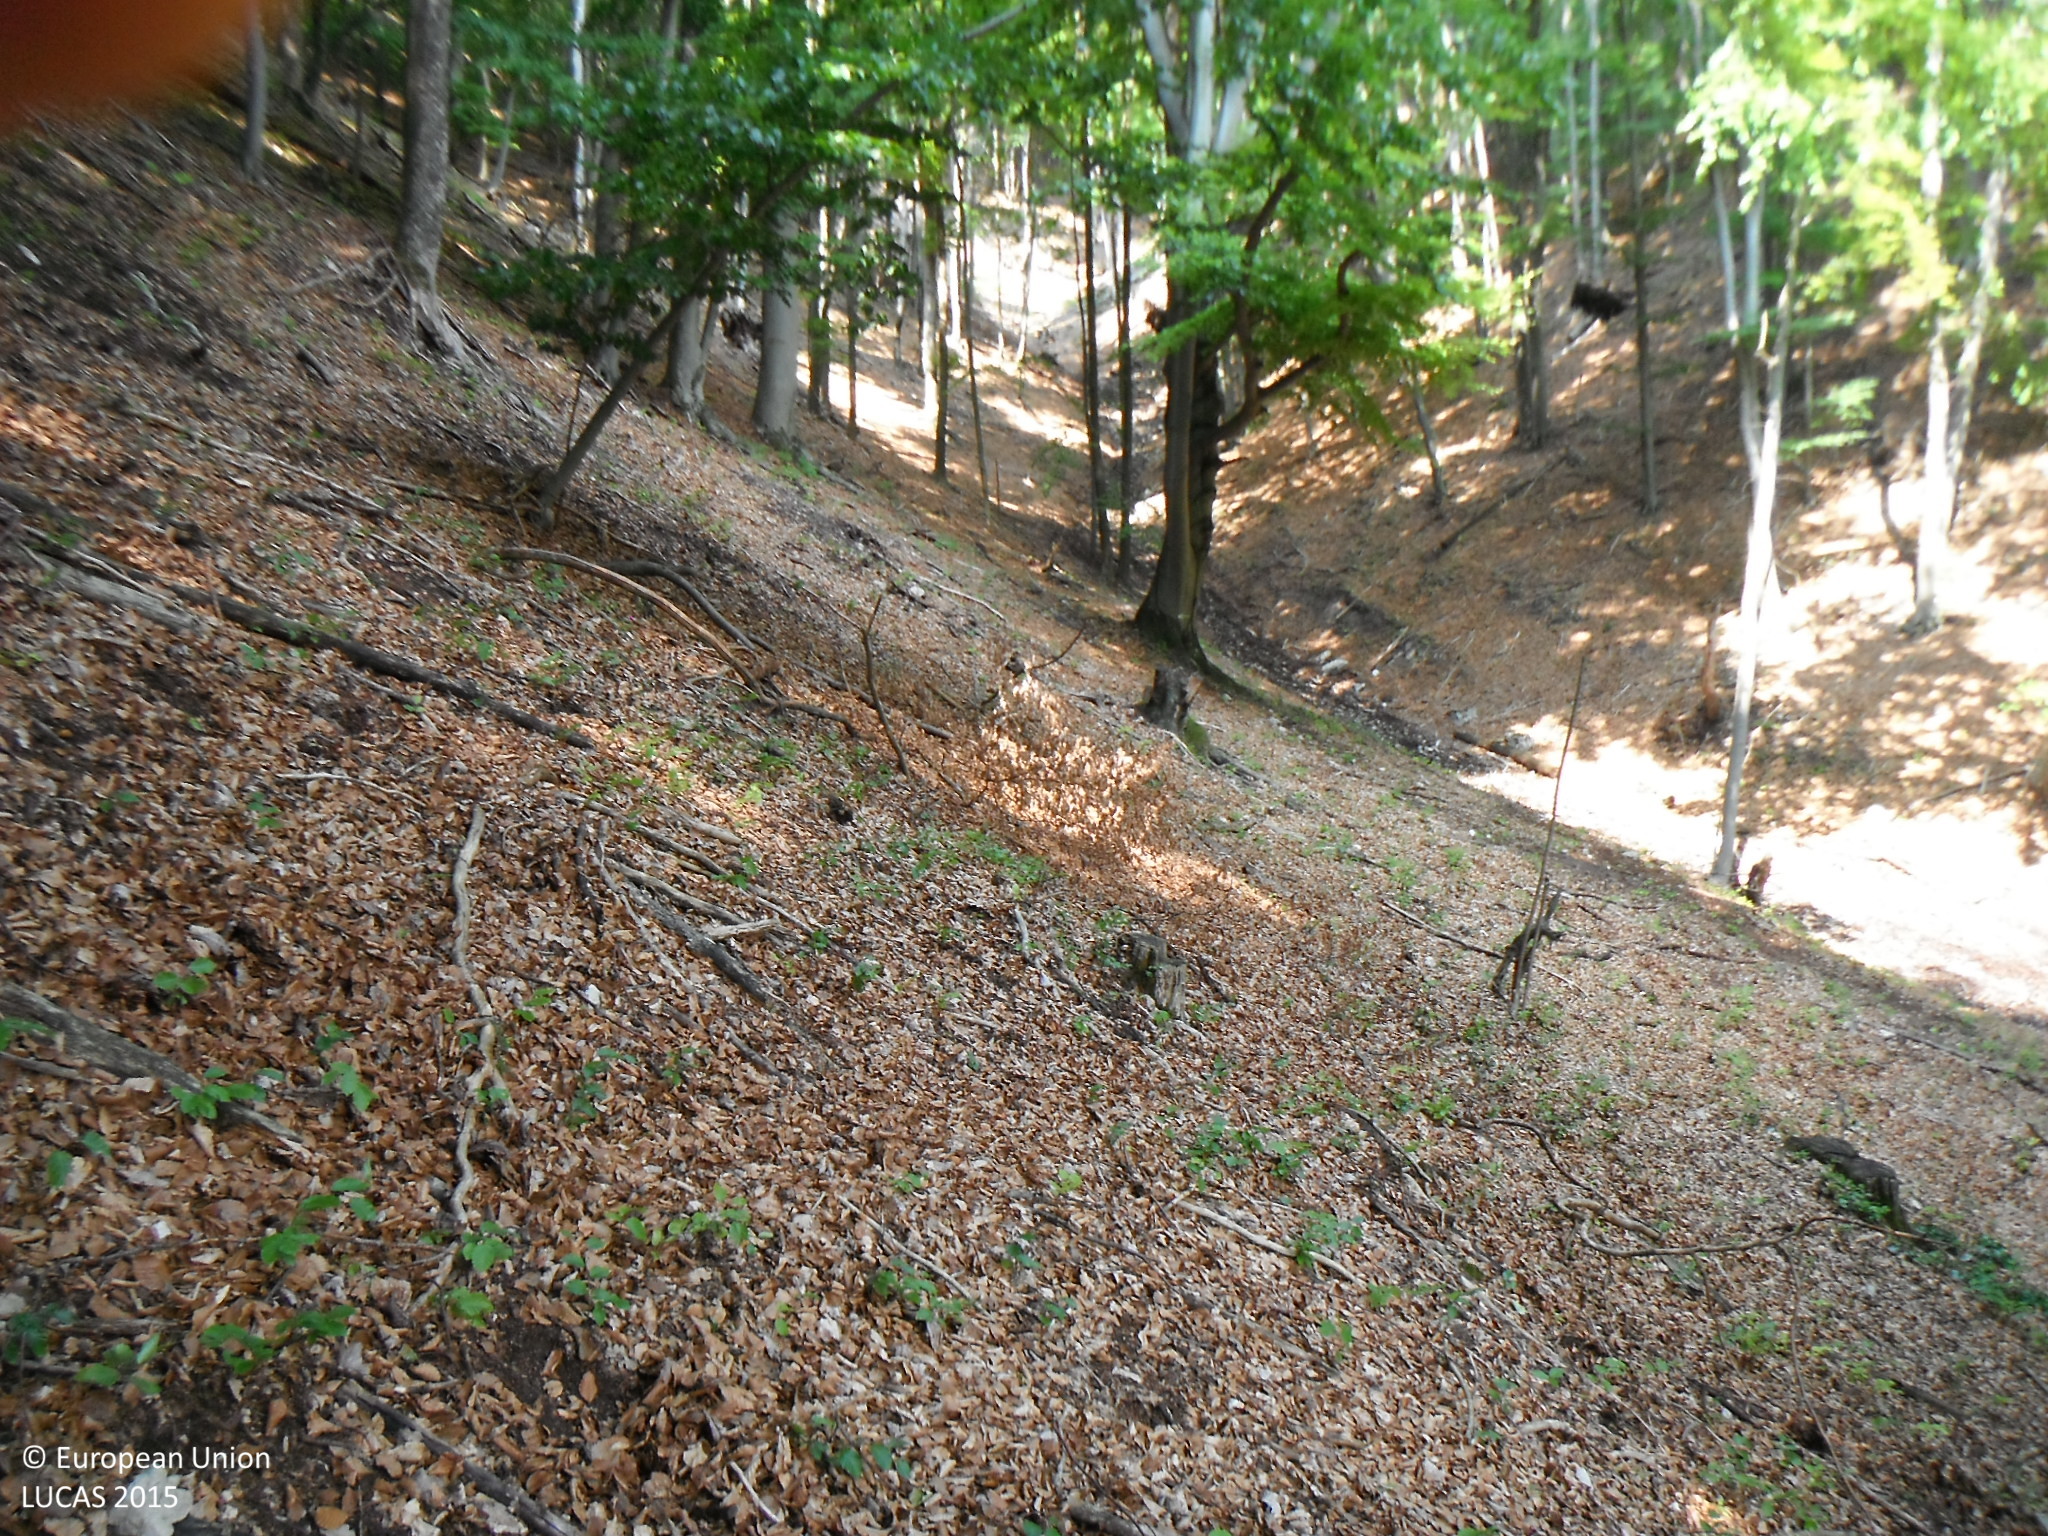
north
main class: Woodland
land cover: Broadleaved woodland
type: mountainous beech forest
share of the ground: > 75 %
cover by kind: broadleaved forest trees 60 %, unconsolidated bare surface 30 %, herbaceous plants 10 %
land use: Forestry
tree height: > 5 m
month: August
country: SK
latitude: 48.9725
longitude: 18.3638
